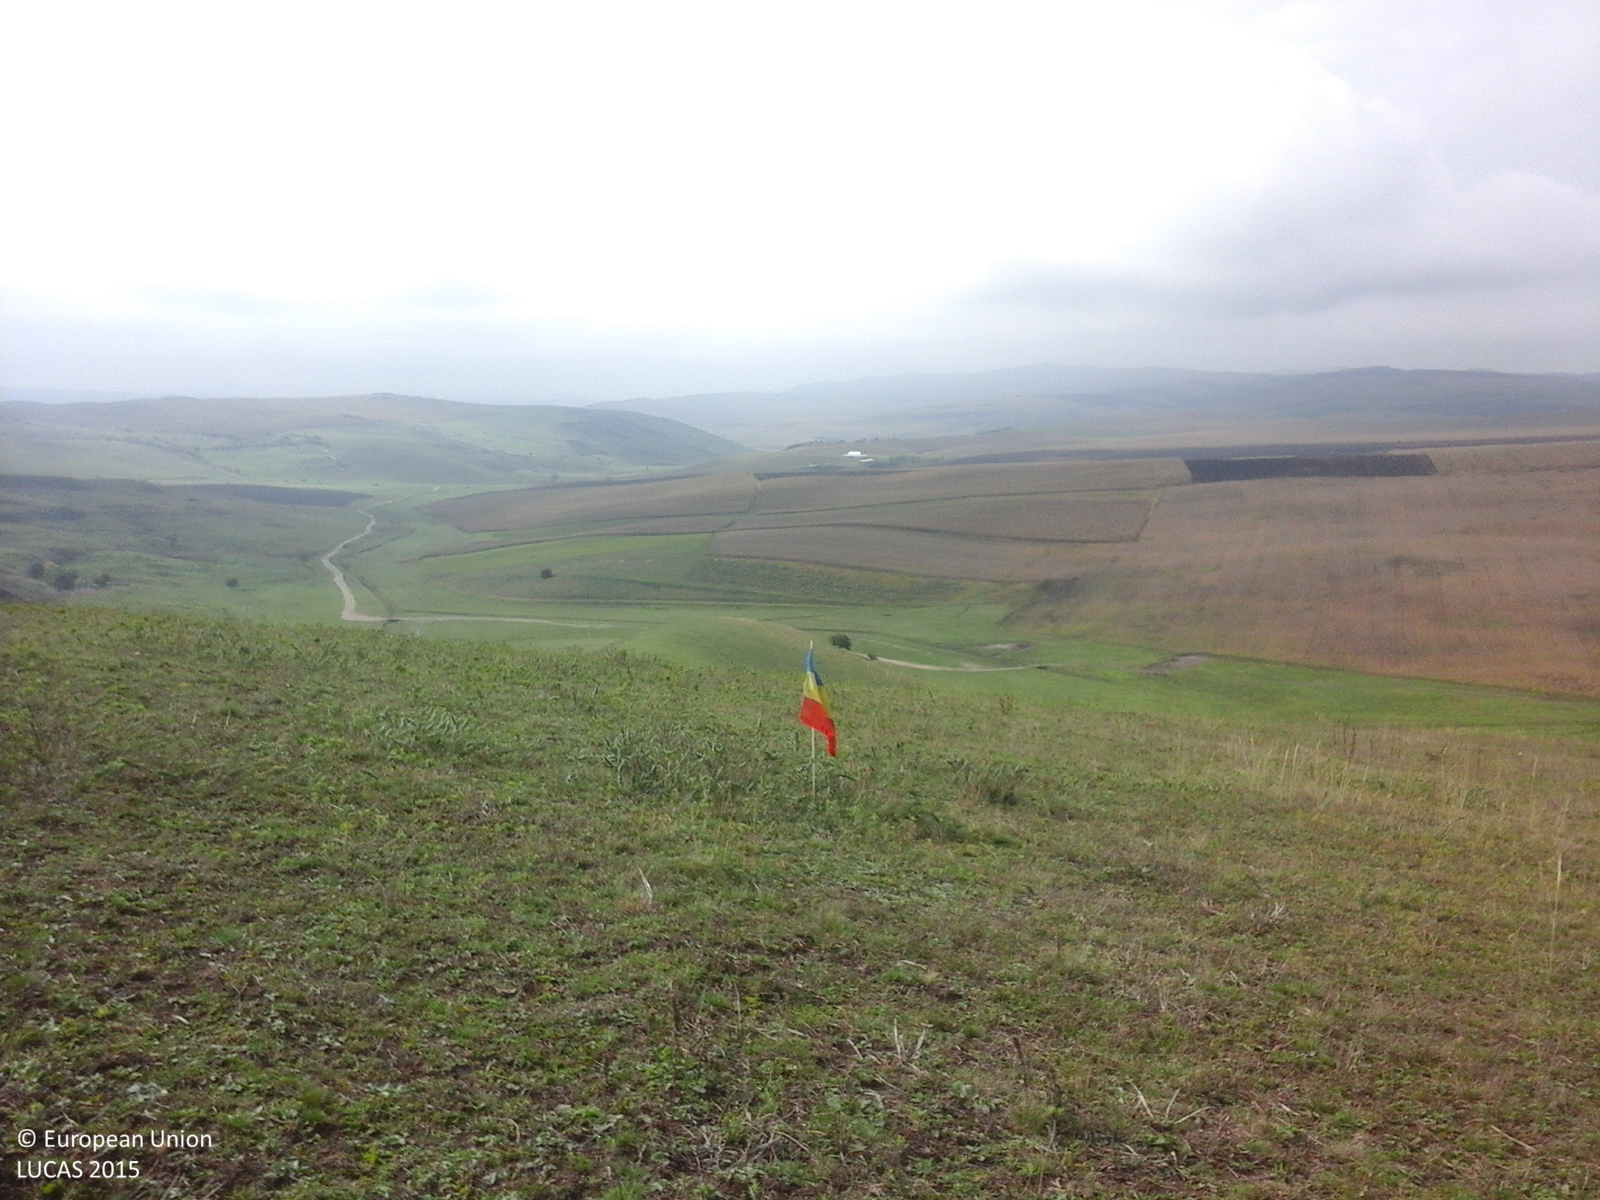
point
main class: Grassland
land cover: Grassland without tree/shrub cover
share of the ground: > 75 %
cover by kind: herbaceous plants 100 %
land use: Agriculture (excluding fallow land and kitchen gardens)
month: October
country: RO
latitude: 46.2657
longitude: 23.9971
